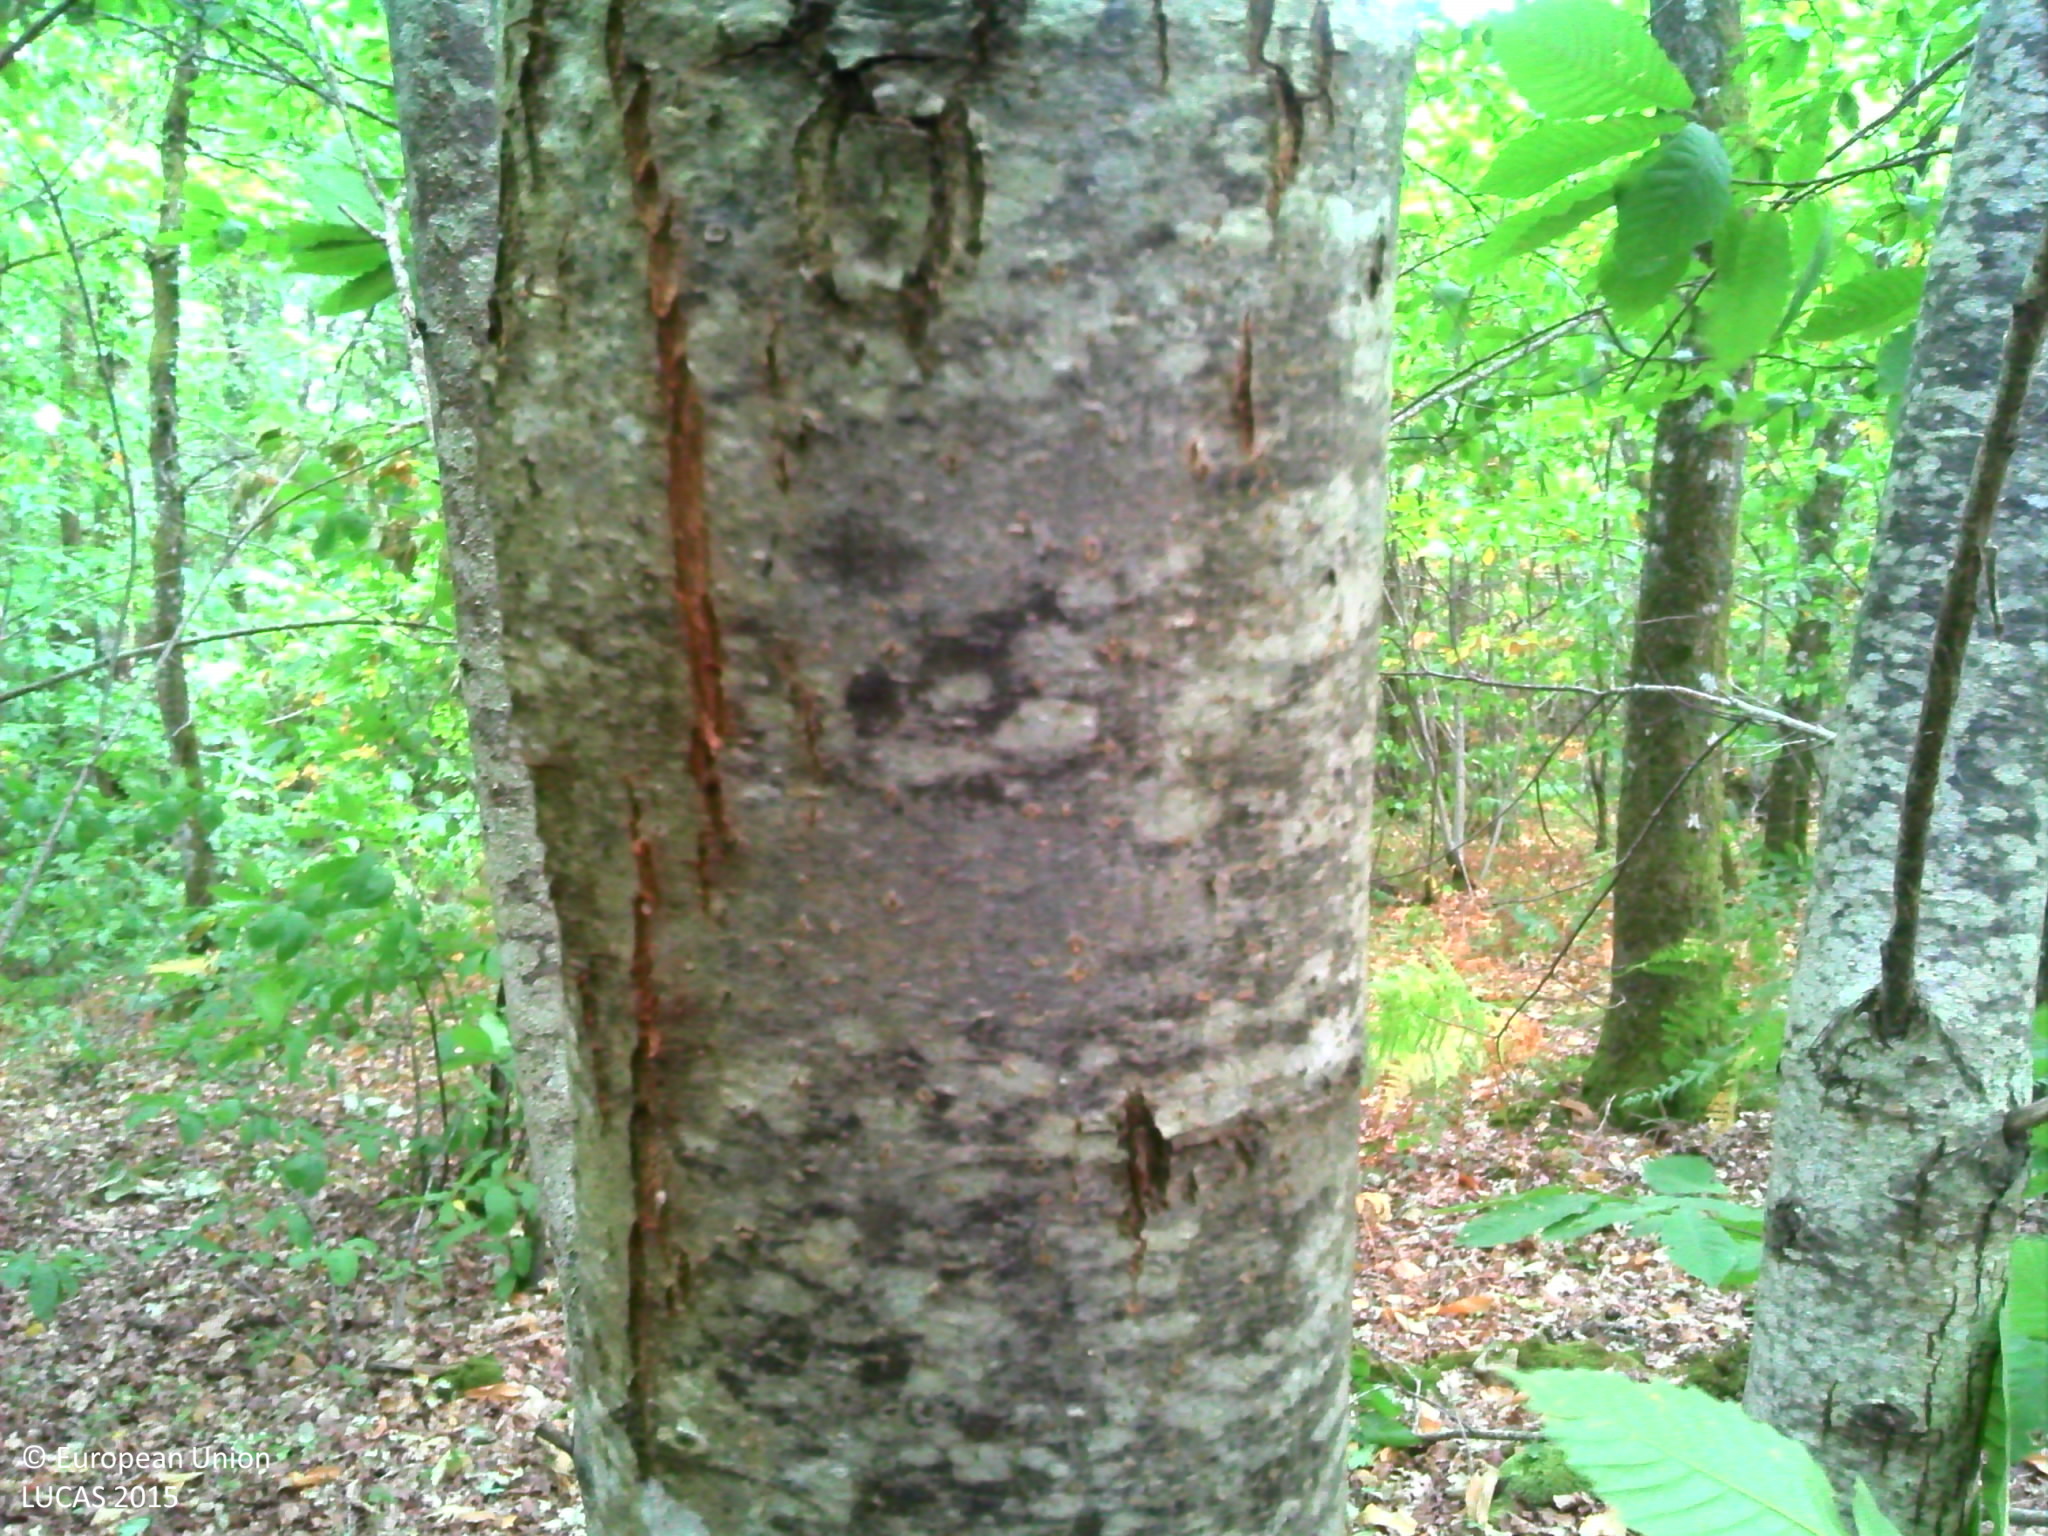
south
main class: Woodland
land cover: Broadleaved woodland
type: mesophytic deciduous forest
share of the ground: > 75 %
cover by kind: broadleaved forest trees 70 %, herbaceous plants 10 %, lichens and mosses 10 %, unconsolidated bare surface 10 %
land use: Forestry
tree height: > 5 m
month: July
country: FR
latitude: 45.6292
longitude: 0.6107
